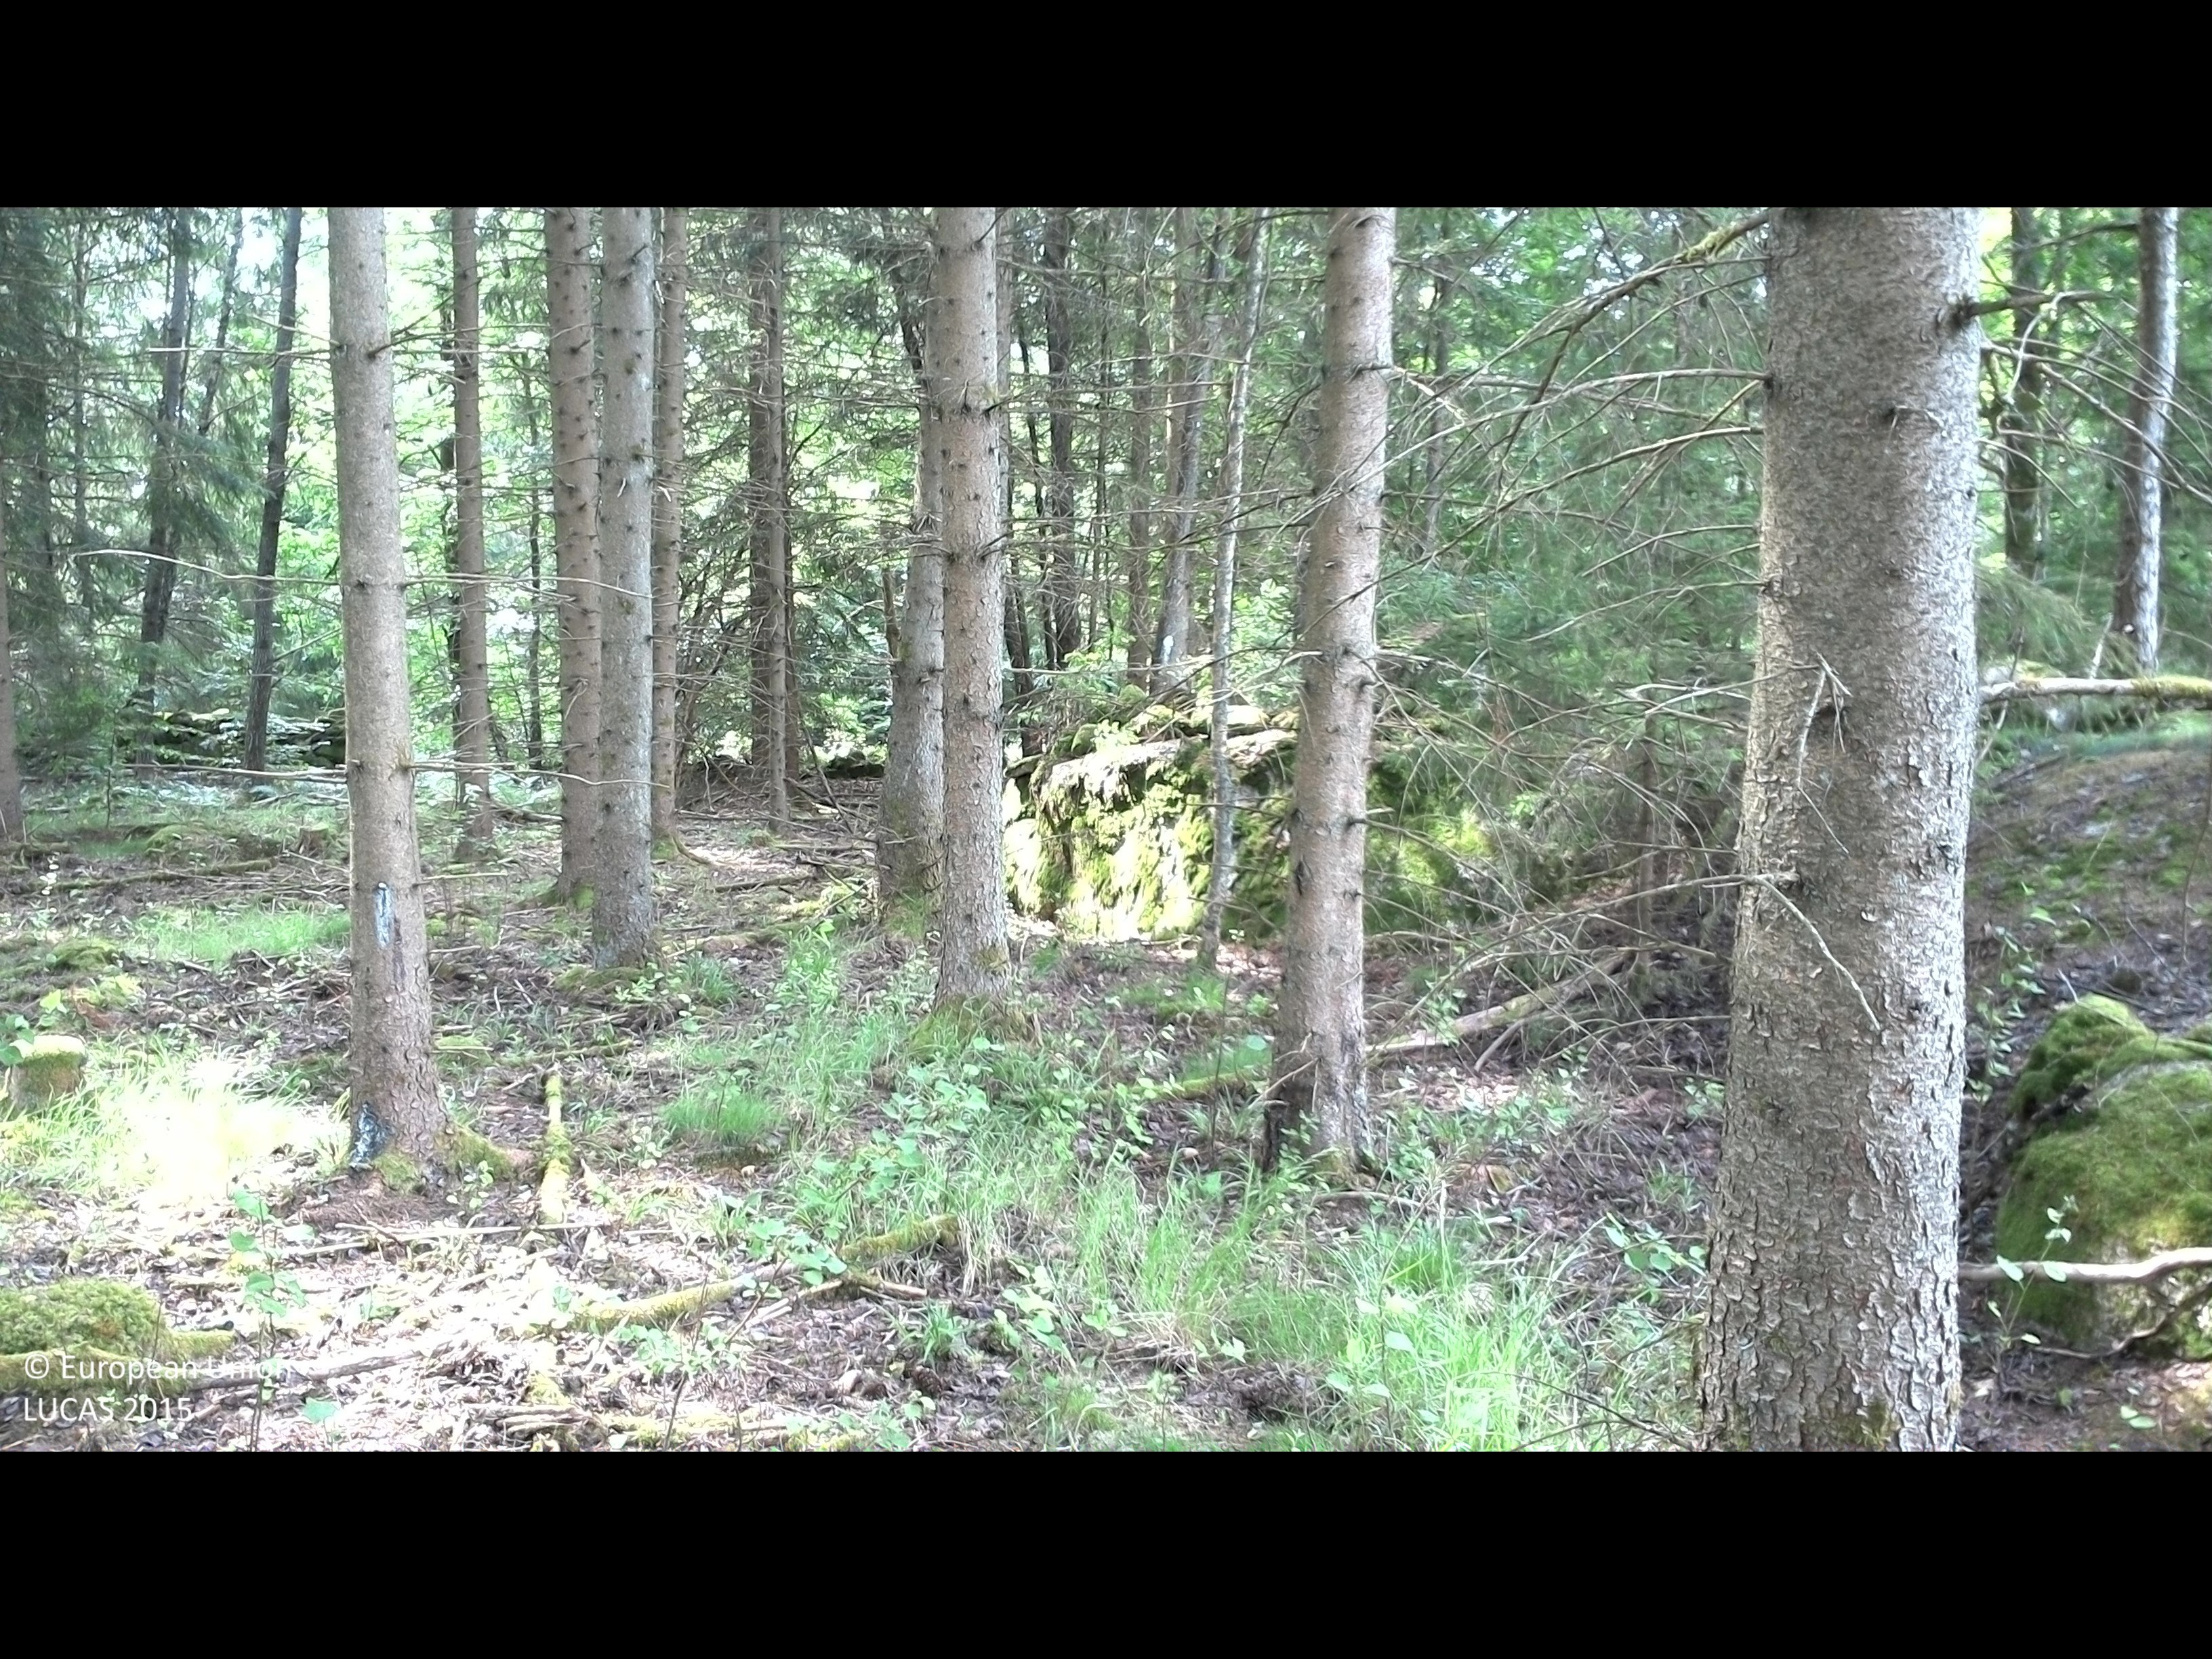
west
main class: Woodland
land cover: Spruce dominated coniferous woodland
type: boreal forest
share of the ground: 50 - 75 %
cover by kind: coniferous forest trees 65 %, lichens and mosses 15 %, broadleaved forest trees 10 %, herbaceous plants 5 %, unconsolidated bare surface 5 %
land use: Forestry
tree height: > 5 m
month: July
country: SE
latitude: 56.3271
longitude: 15.3843
